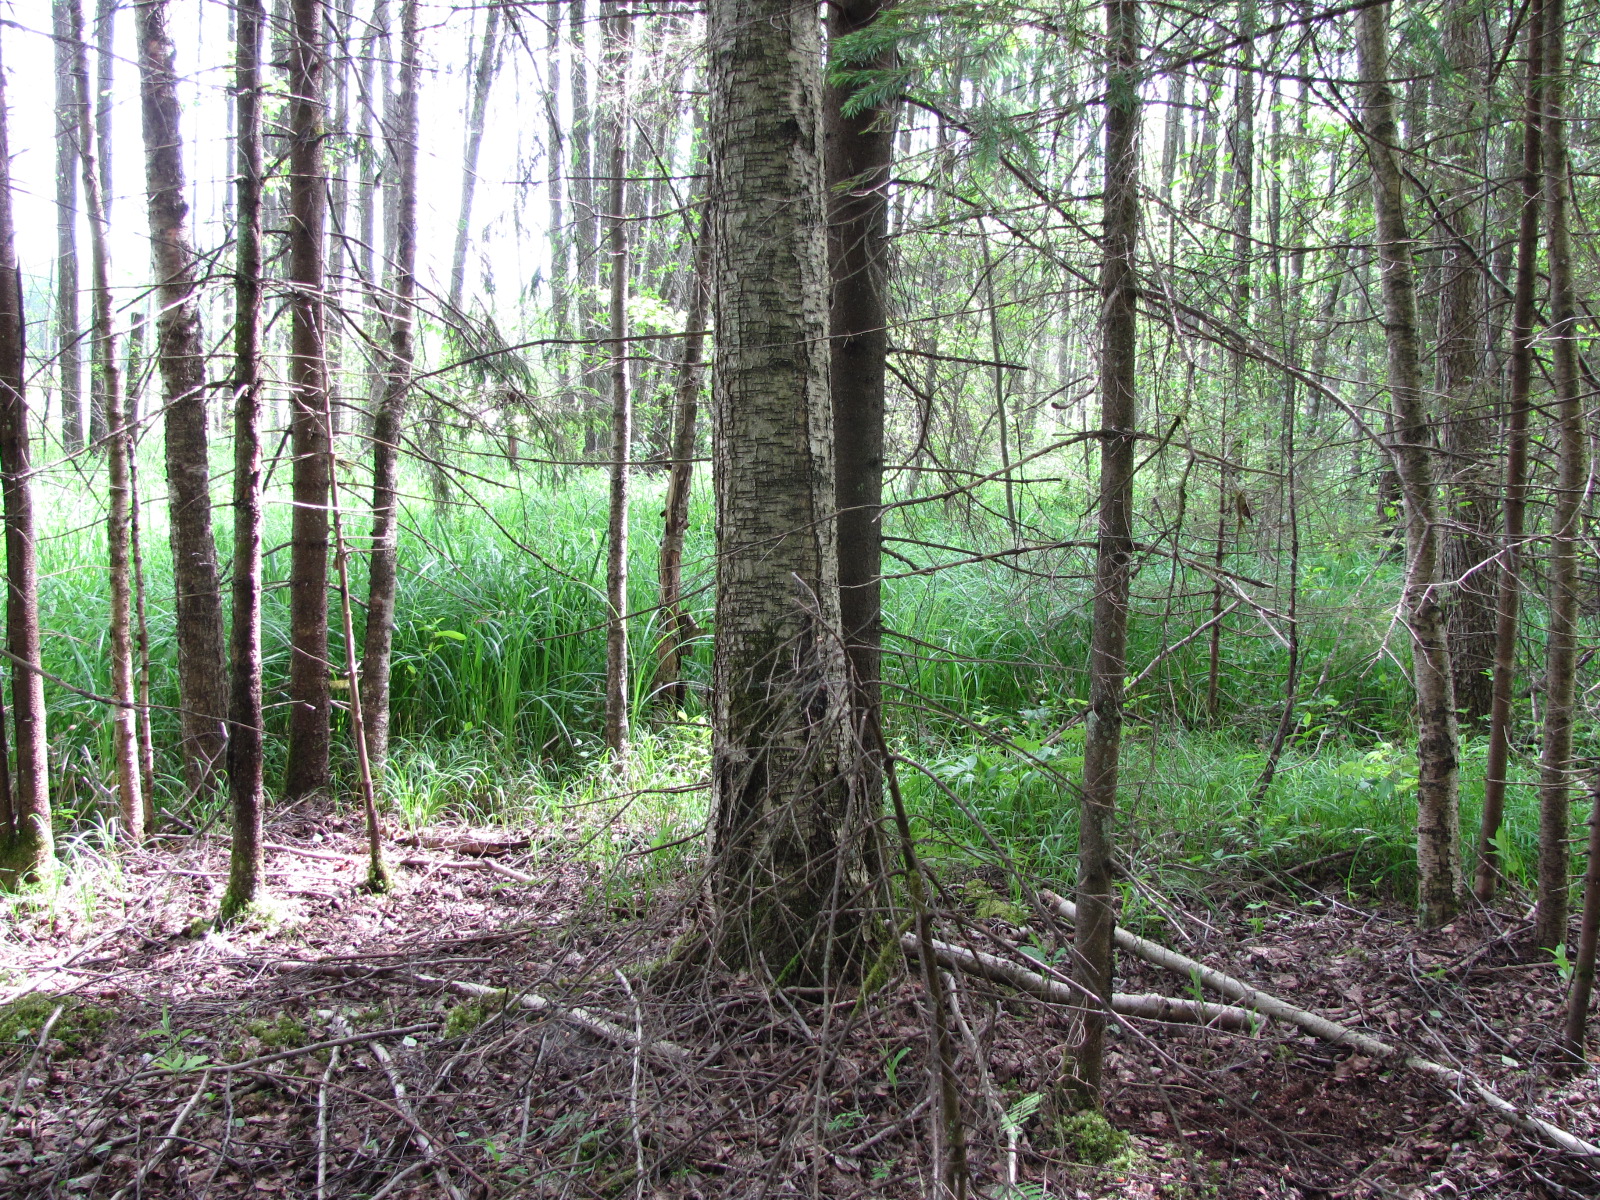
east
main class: Woodland
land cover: Spruce dominated mixed woodland
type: hemiboreal forest and nemoral coniferous forest and mixed broadleaved-coniferous forest
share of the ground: > 75 %
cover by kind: broadleaved forest trees 60 %, coniferous forest trees 40 %
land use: Forestry
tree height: > 5 m
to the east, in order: Spruce dominated mixed woodland; Grassland with sparse tree/shrub cover; Spontaneously vegetated surfaces; Grassland without tree/shrub cover; Paved roads, cycling and walking lanes; Grassland without tree/shrub cover; Other bare soil; Spontaneously vegetated surfaces; Grassland with sparse tree/shrub cover; Pine dominated mixed woodland; Spruce dominated coniferous woodland
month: June
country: LV
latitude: 56.6547
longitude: 23.8651
